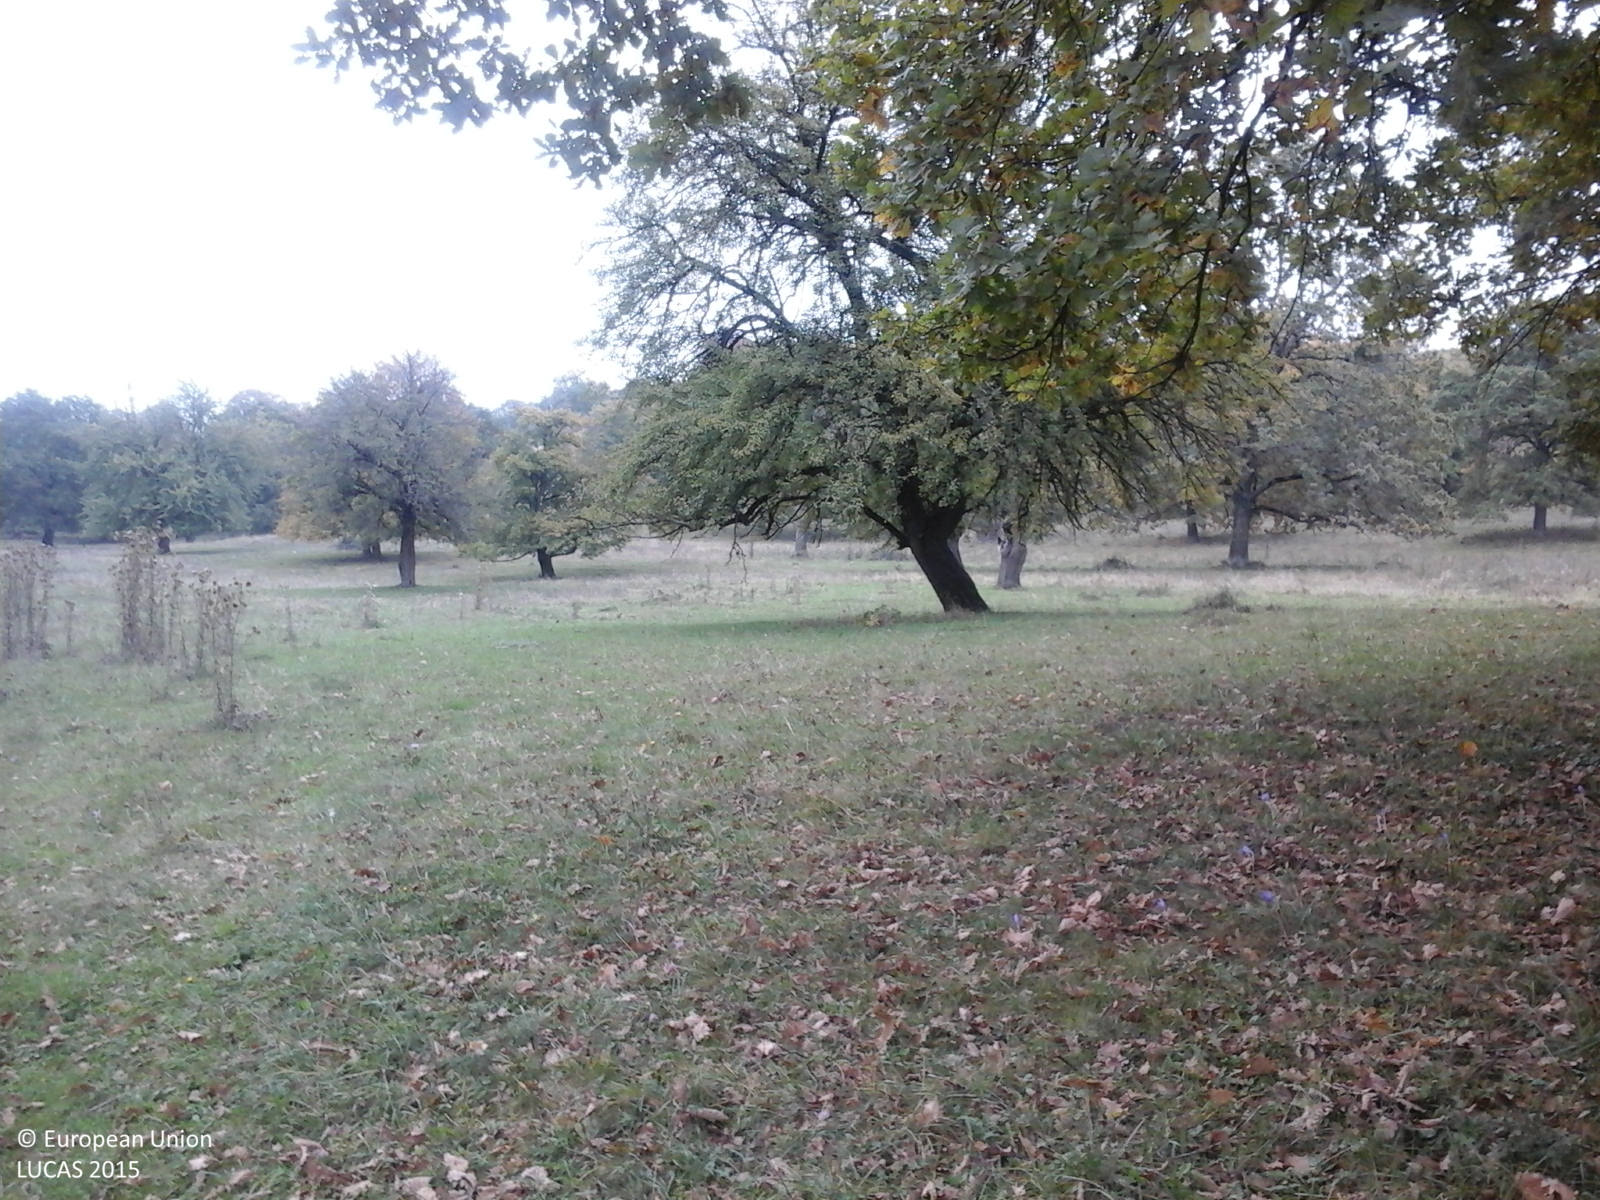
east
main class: Grassland
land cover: Grassland with sparse tree/shrub cover
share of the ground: > 75 %
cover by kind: herbaceous plants 95 %, broadleaved forest trees 5 %
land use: Agriculture (excluding fallow land and kitchen gardens)
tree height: > 5 m
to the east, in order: Grassland with sparse tree/shrub cover
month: October
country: RO
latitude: 46.0049
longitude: 25.2204
